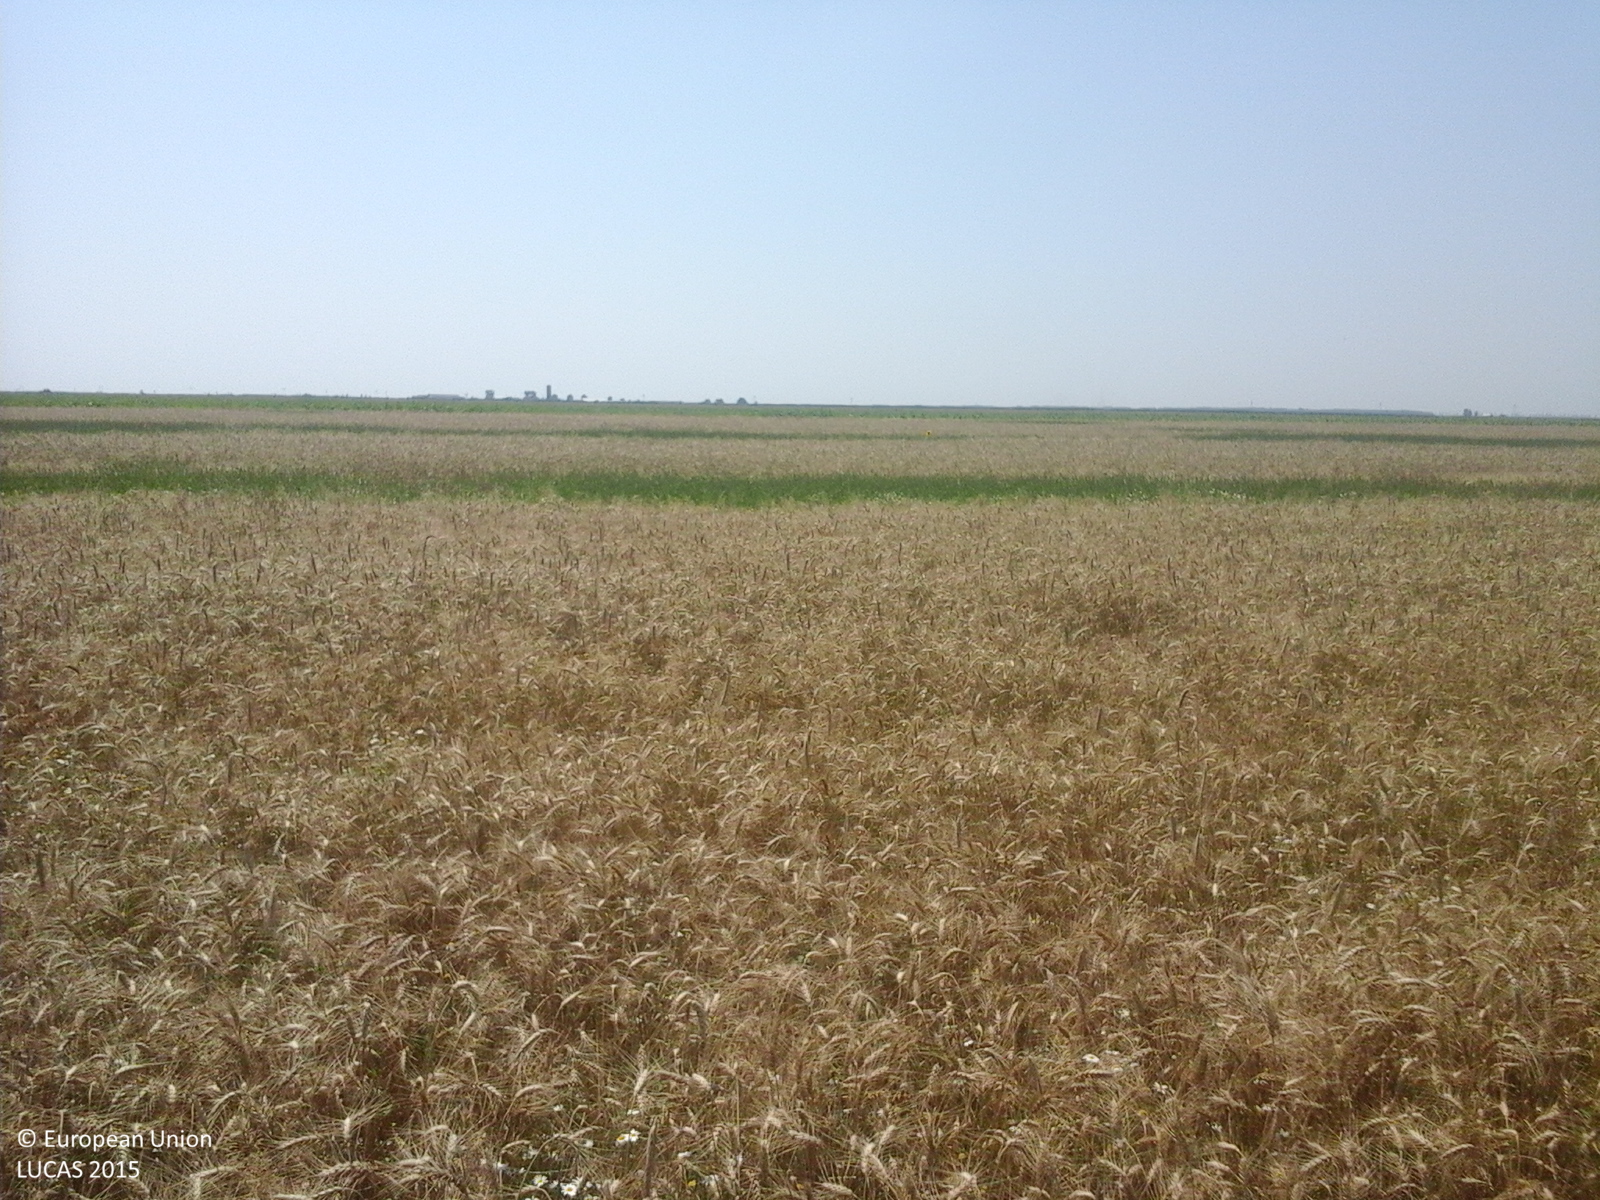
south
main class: Cropland
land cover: Common wheat
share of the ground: > 75 %
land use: Agriculture (excluding fallow land and kitchen gardens)
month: July
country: RO
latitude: 44.3210
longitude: 24.9620
